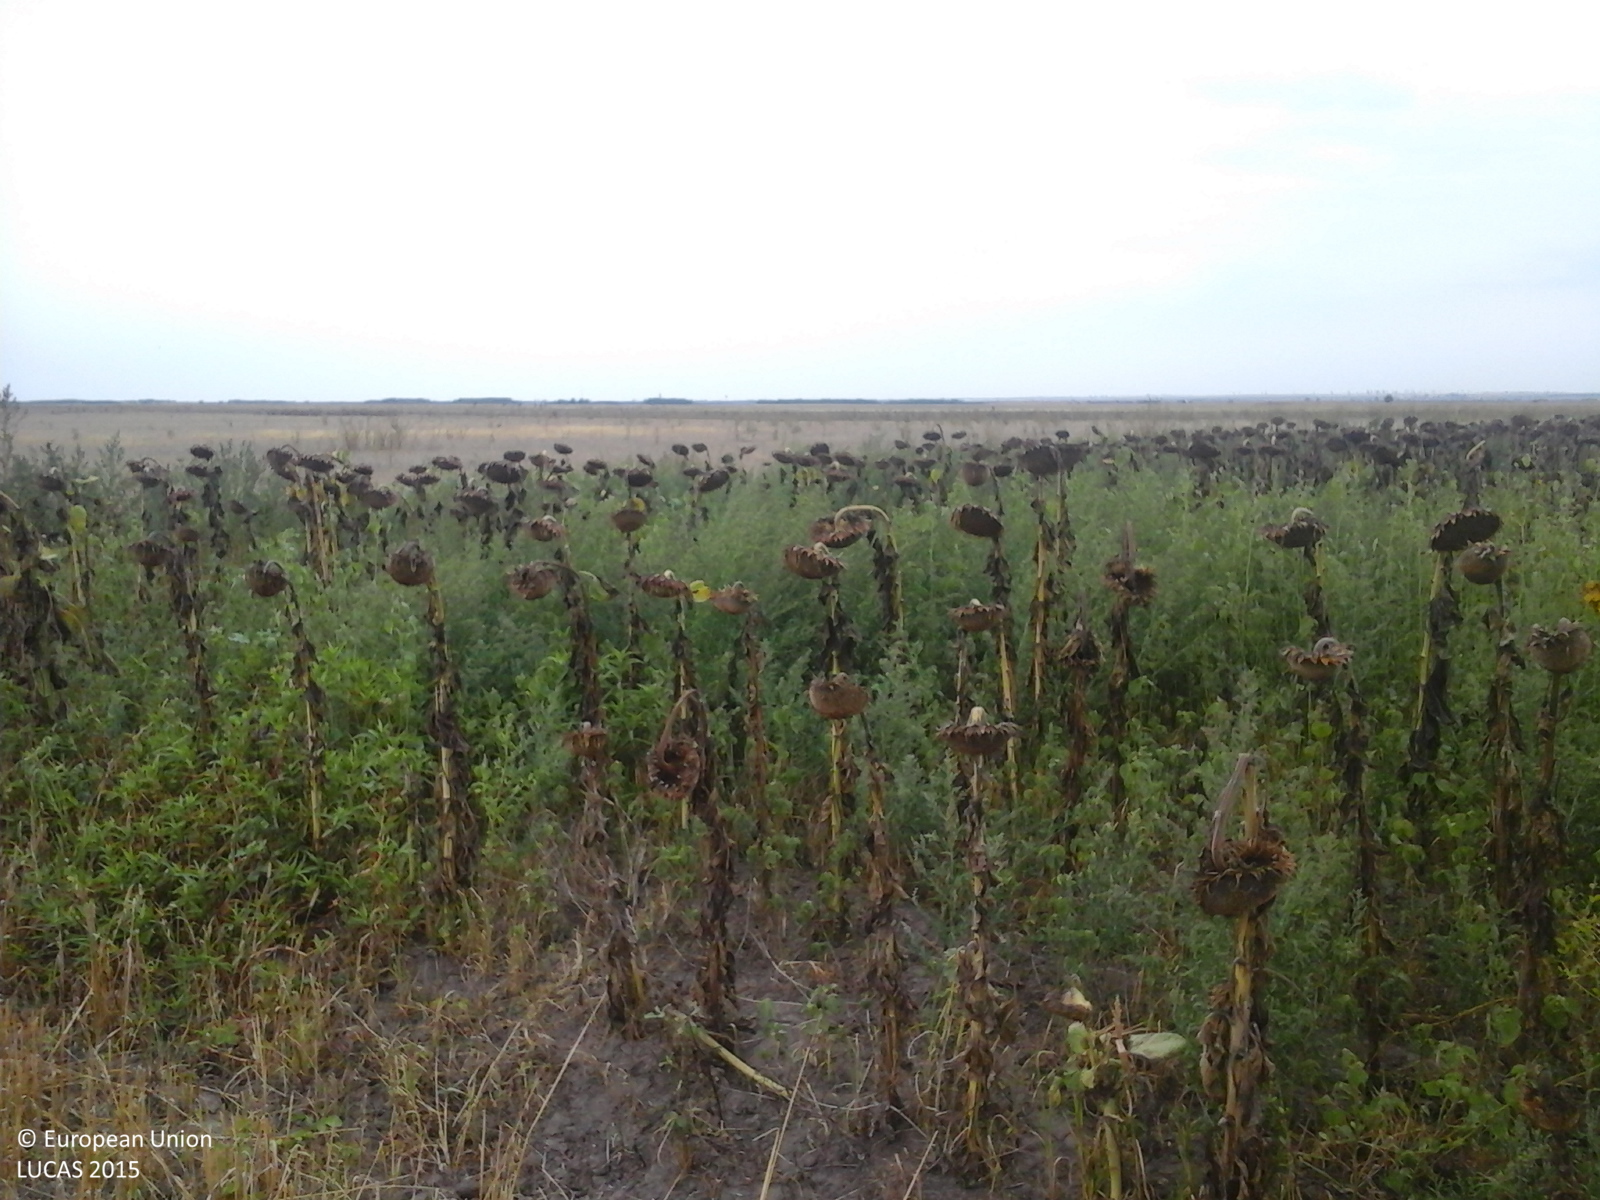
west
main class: Cropland
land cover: Barley
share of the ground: > 75 %
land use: Agriculture (excluding fallow land and kitchen gardens)
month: September
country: RO
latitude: 47.6446
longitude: 22.5854
